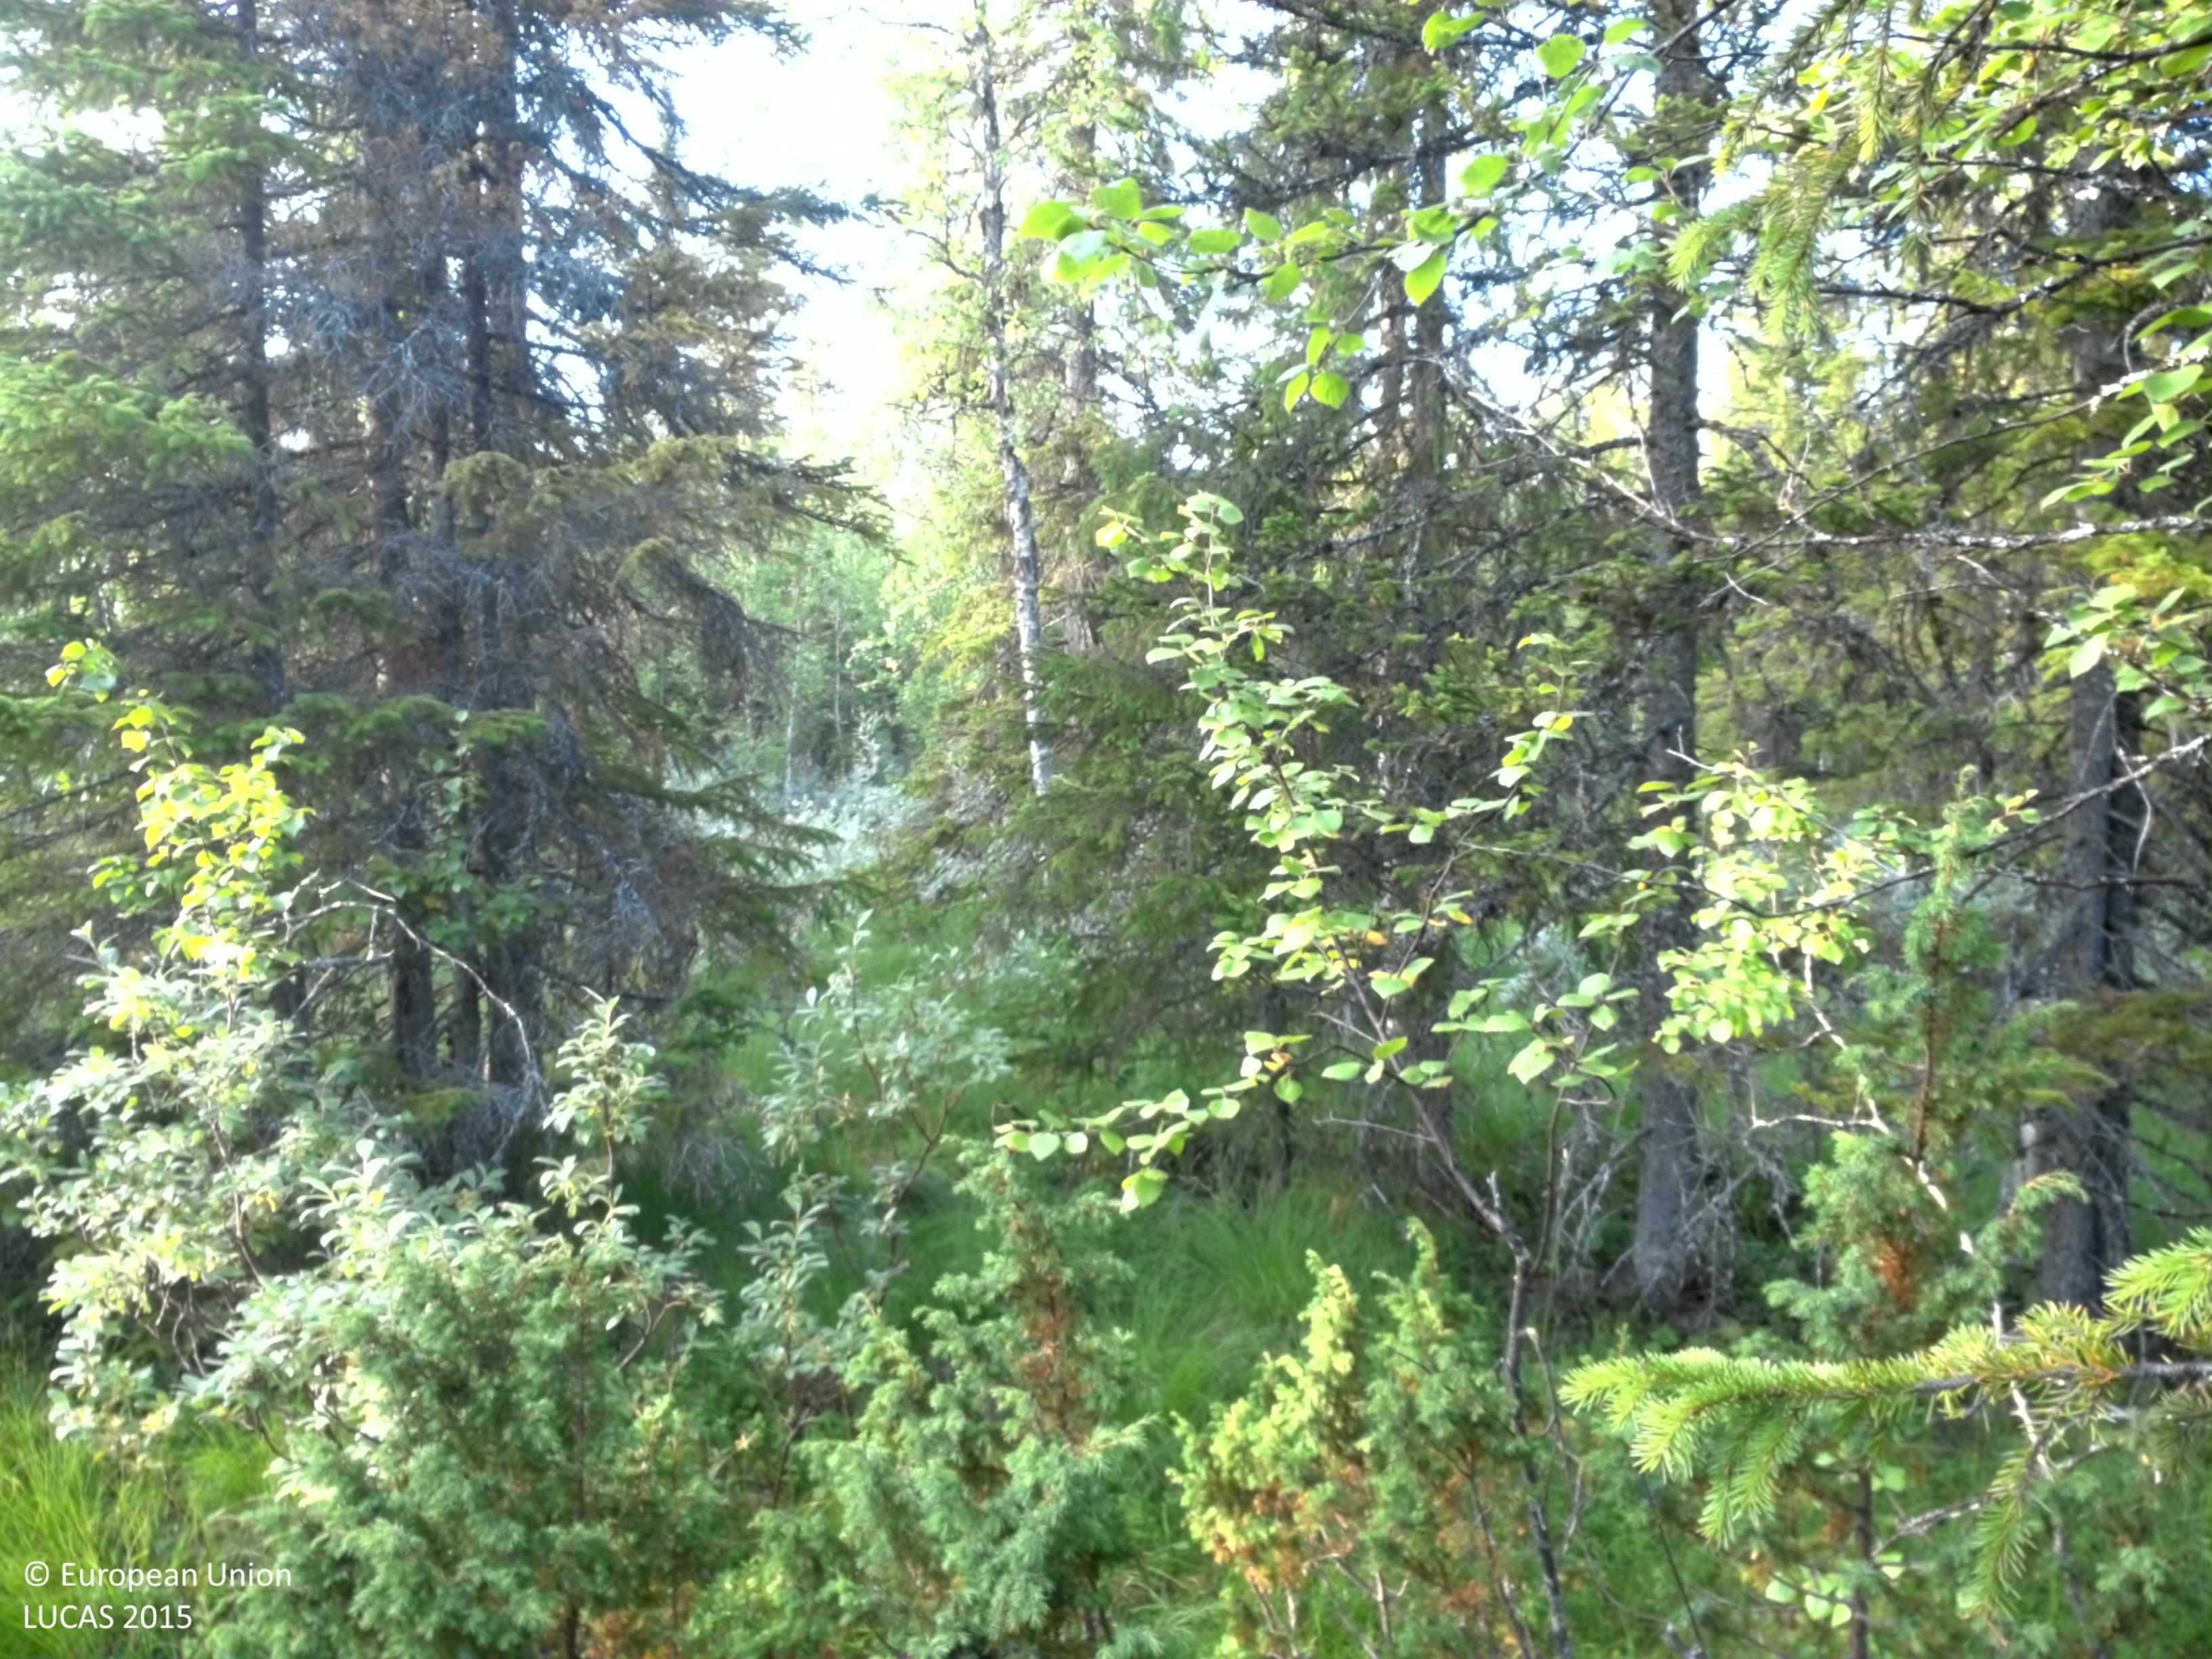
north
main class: Woodland
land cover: Spruce dominated mixed woodland
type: boreal forest
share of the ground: 25 - 50 %
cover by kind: coniferous forest trees 30 %, shrubs 25 %, herbaceous plants 25 %, broadleaved forest trees 15 %, lichens and mosses 5 %
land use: Forestry
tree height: > 5 m
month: August
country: SE
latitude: 64.7167
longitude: 16.0739
